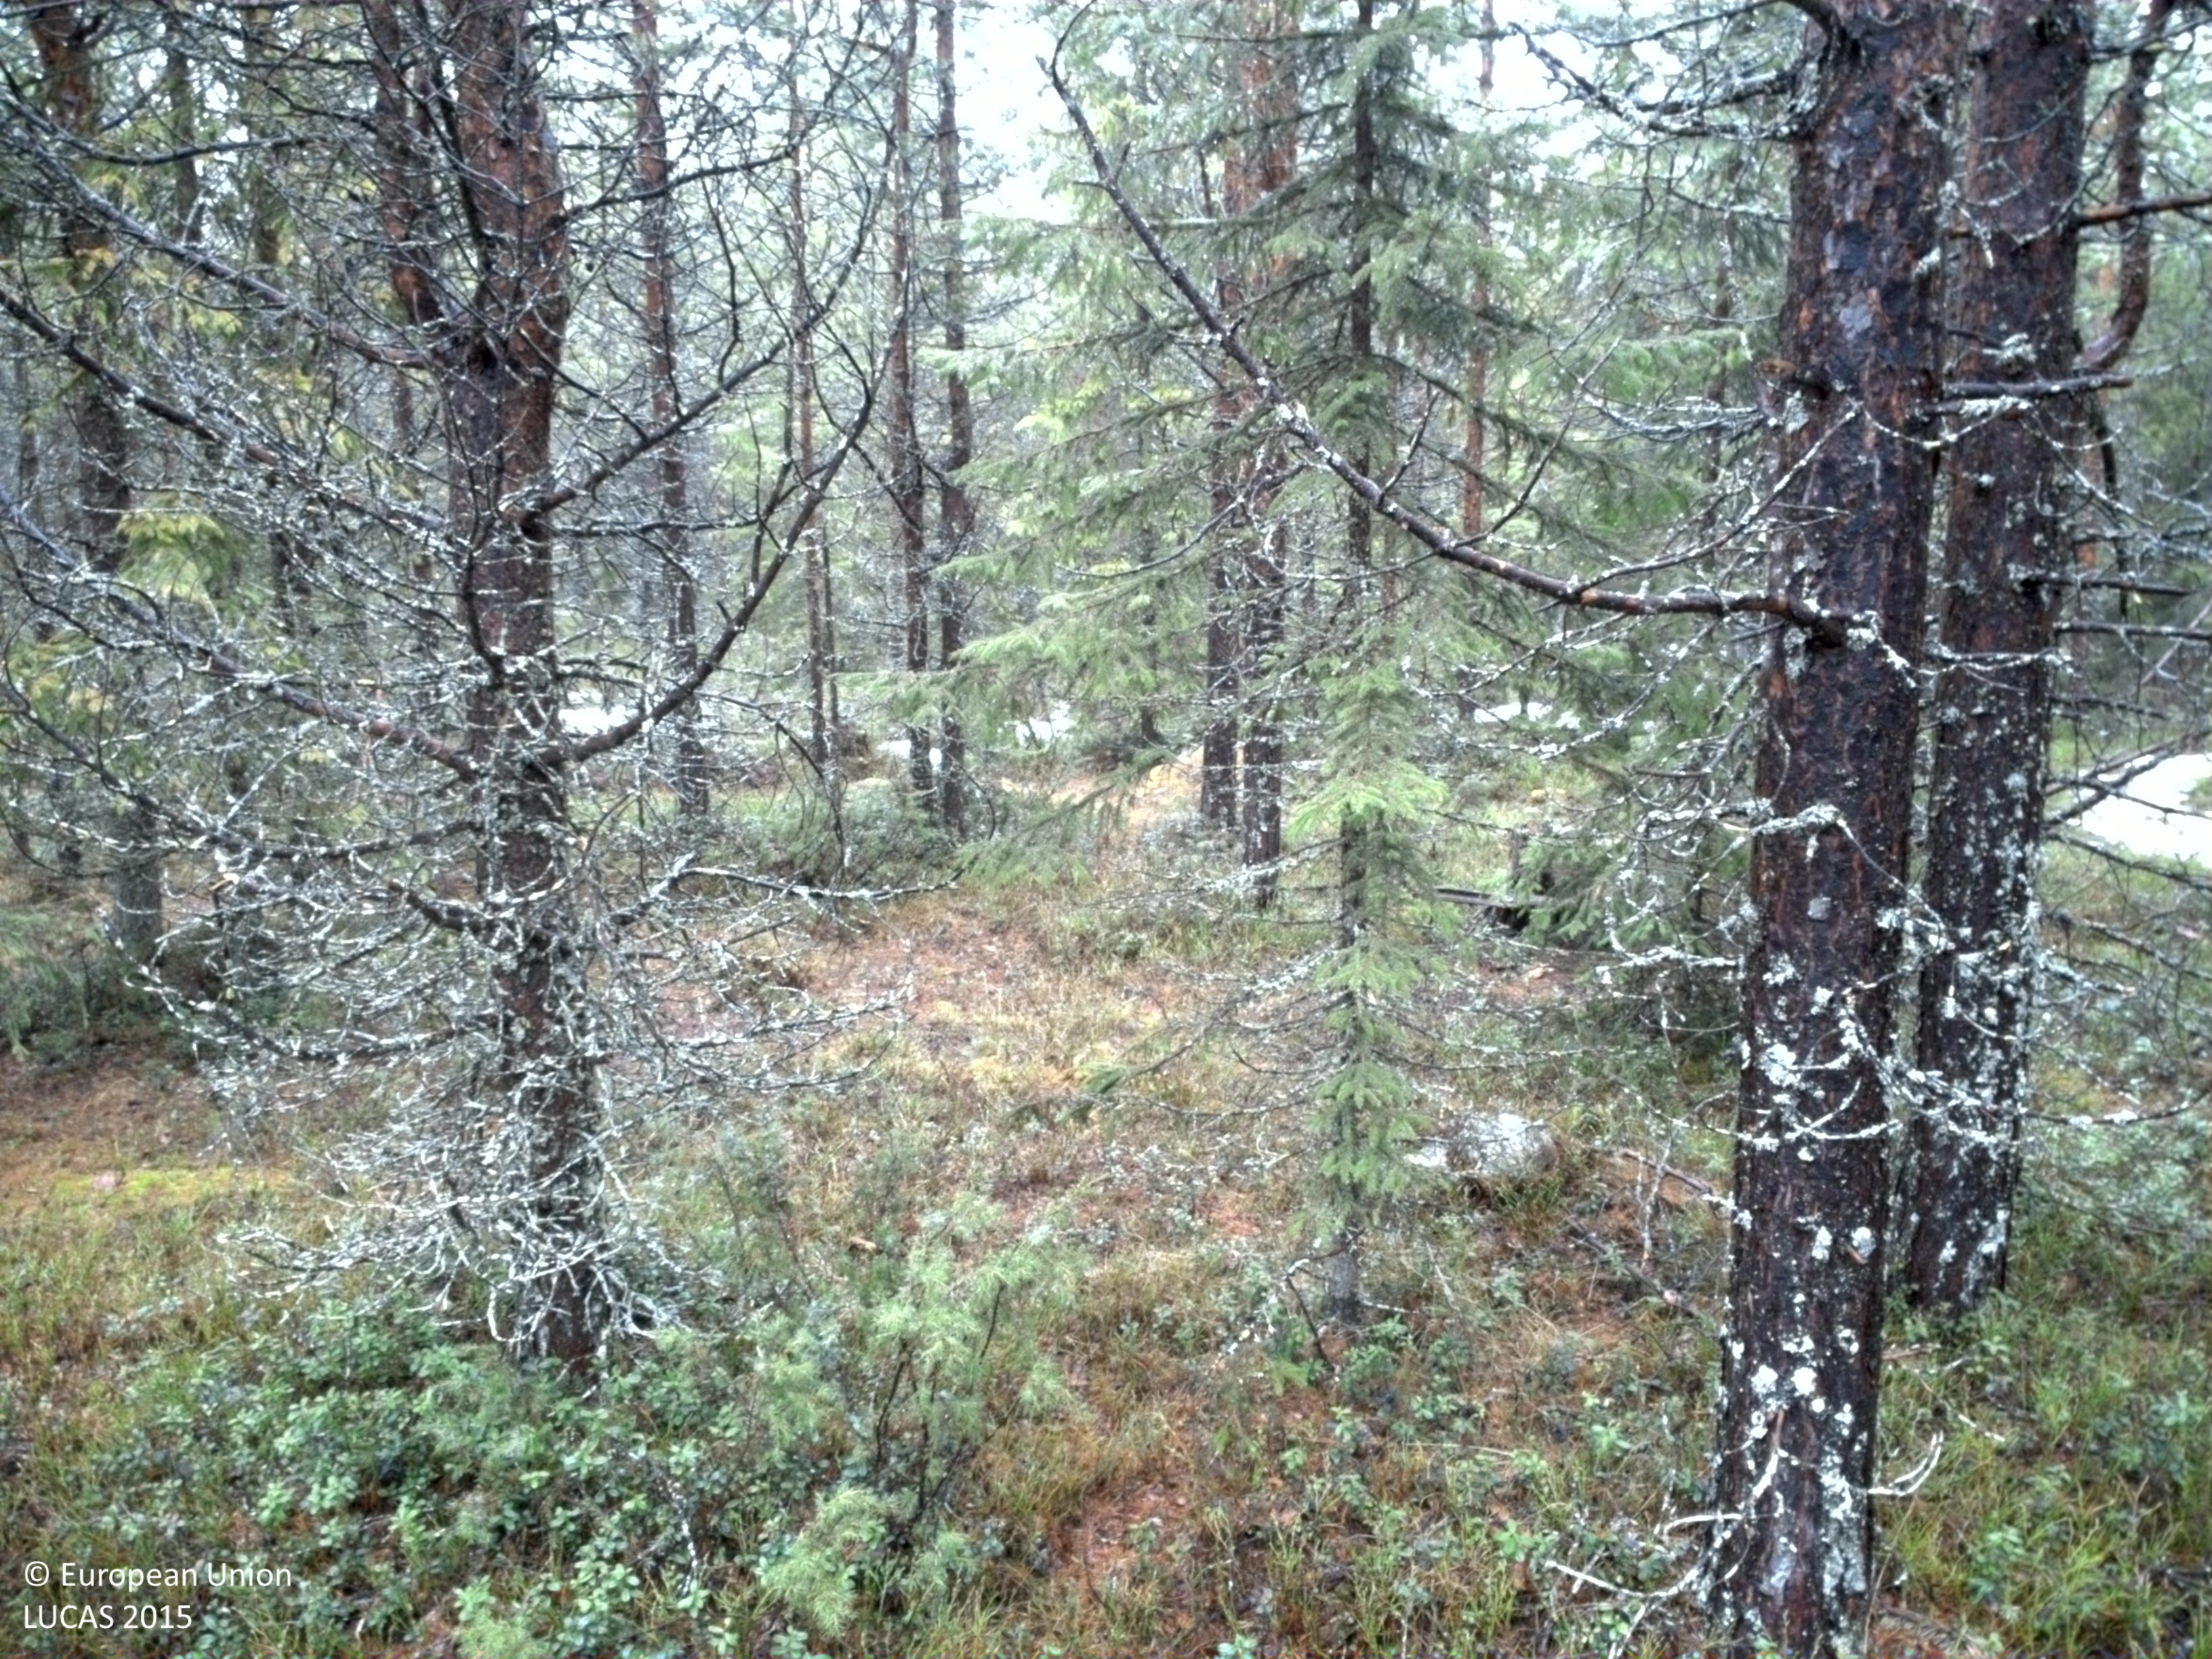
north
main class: Woodland
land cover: Pine dominated coniferous woodland
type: boreal forest
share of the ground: > 75 %
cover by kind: coniferous forest trees 75 %, shrubs 20 %, lichens and mosses 5 %
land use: Forestry
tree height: > 5 m
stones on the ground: 25 - 50 %
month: May
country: SE
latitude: 66.2437
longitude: 23.3101
